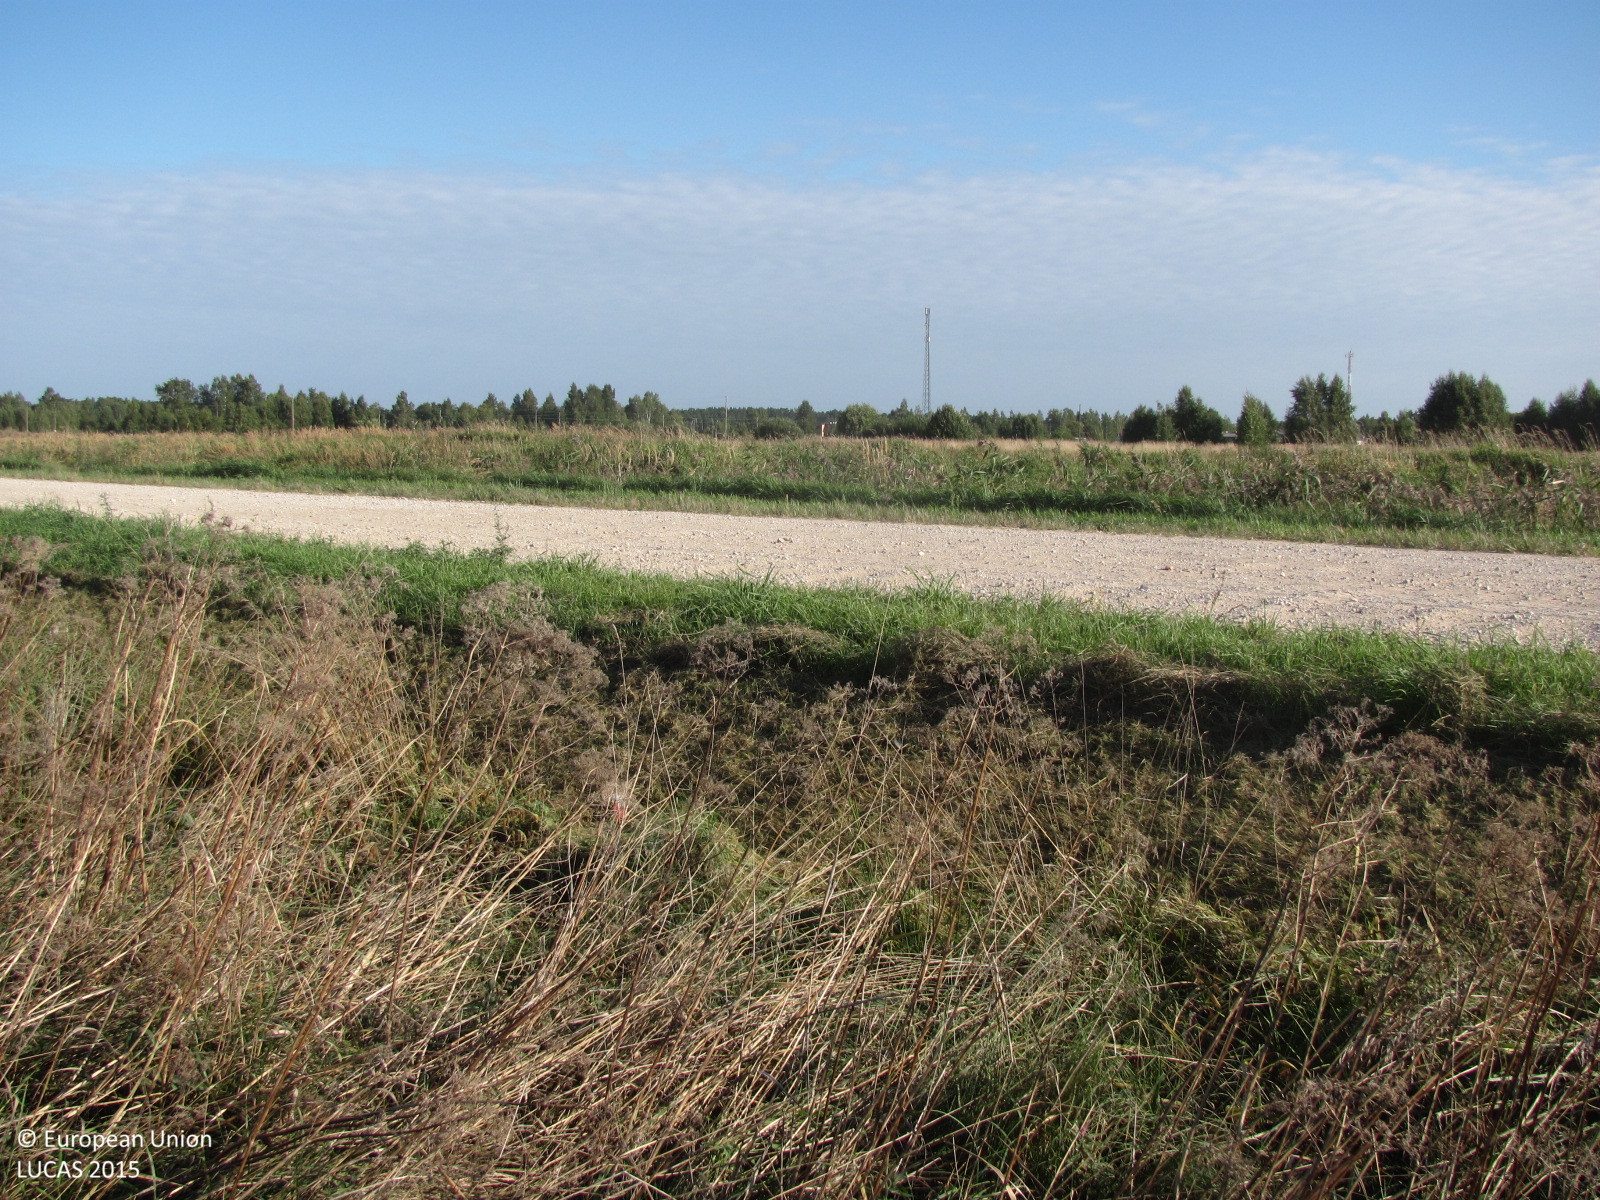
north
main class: Grassland
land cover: Grassland without tree/shrub cover
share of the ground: > 75 %
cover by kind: herbaceous plants 100 %
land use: Agriculture (excluding fallow land and kitchen gardens)
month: September
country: LV
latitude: 57.0942
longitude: 24.1978
